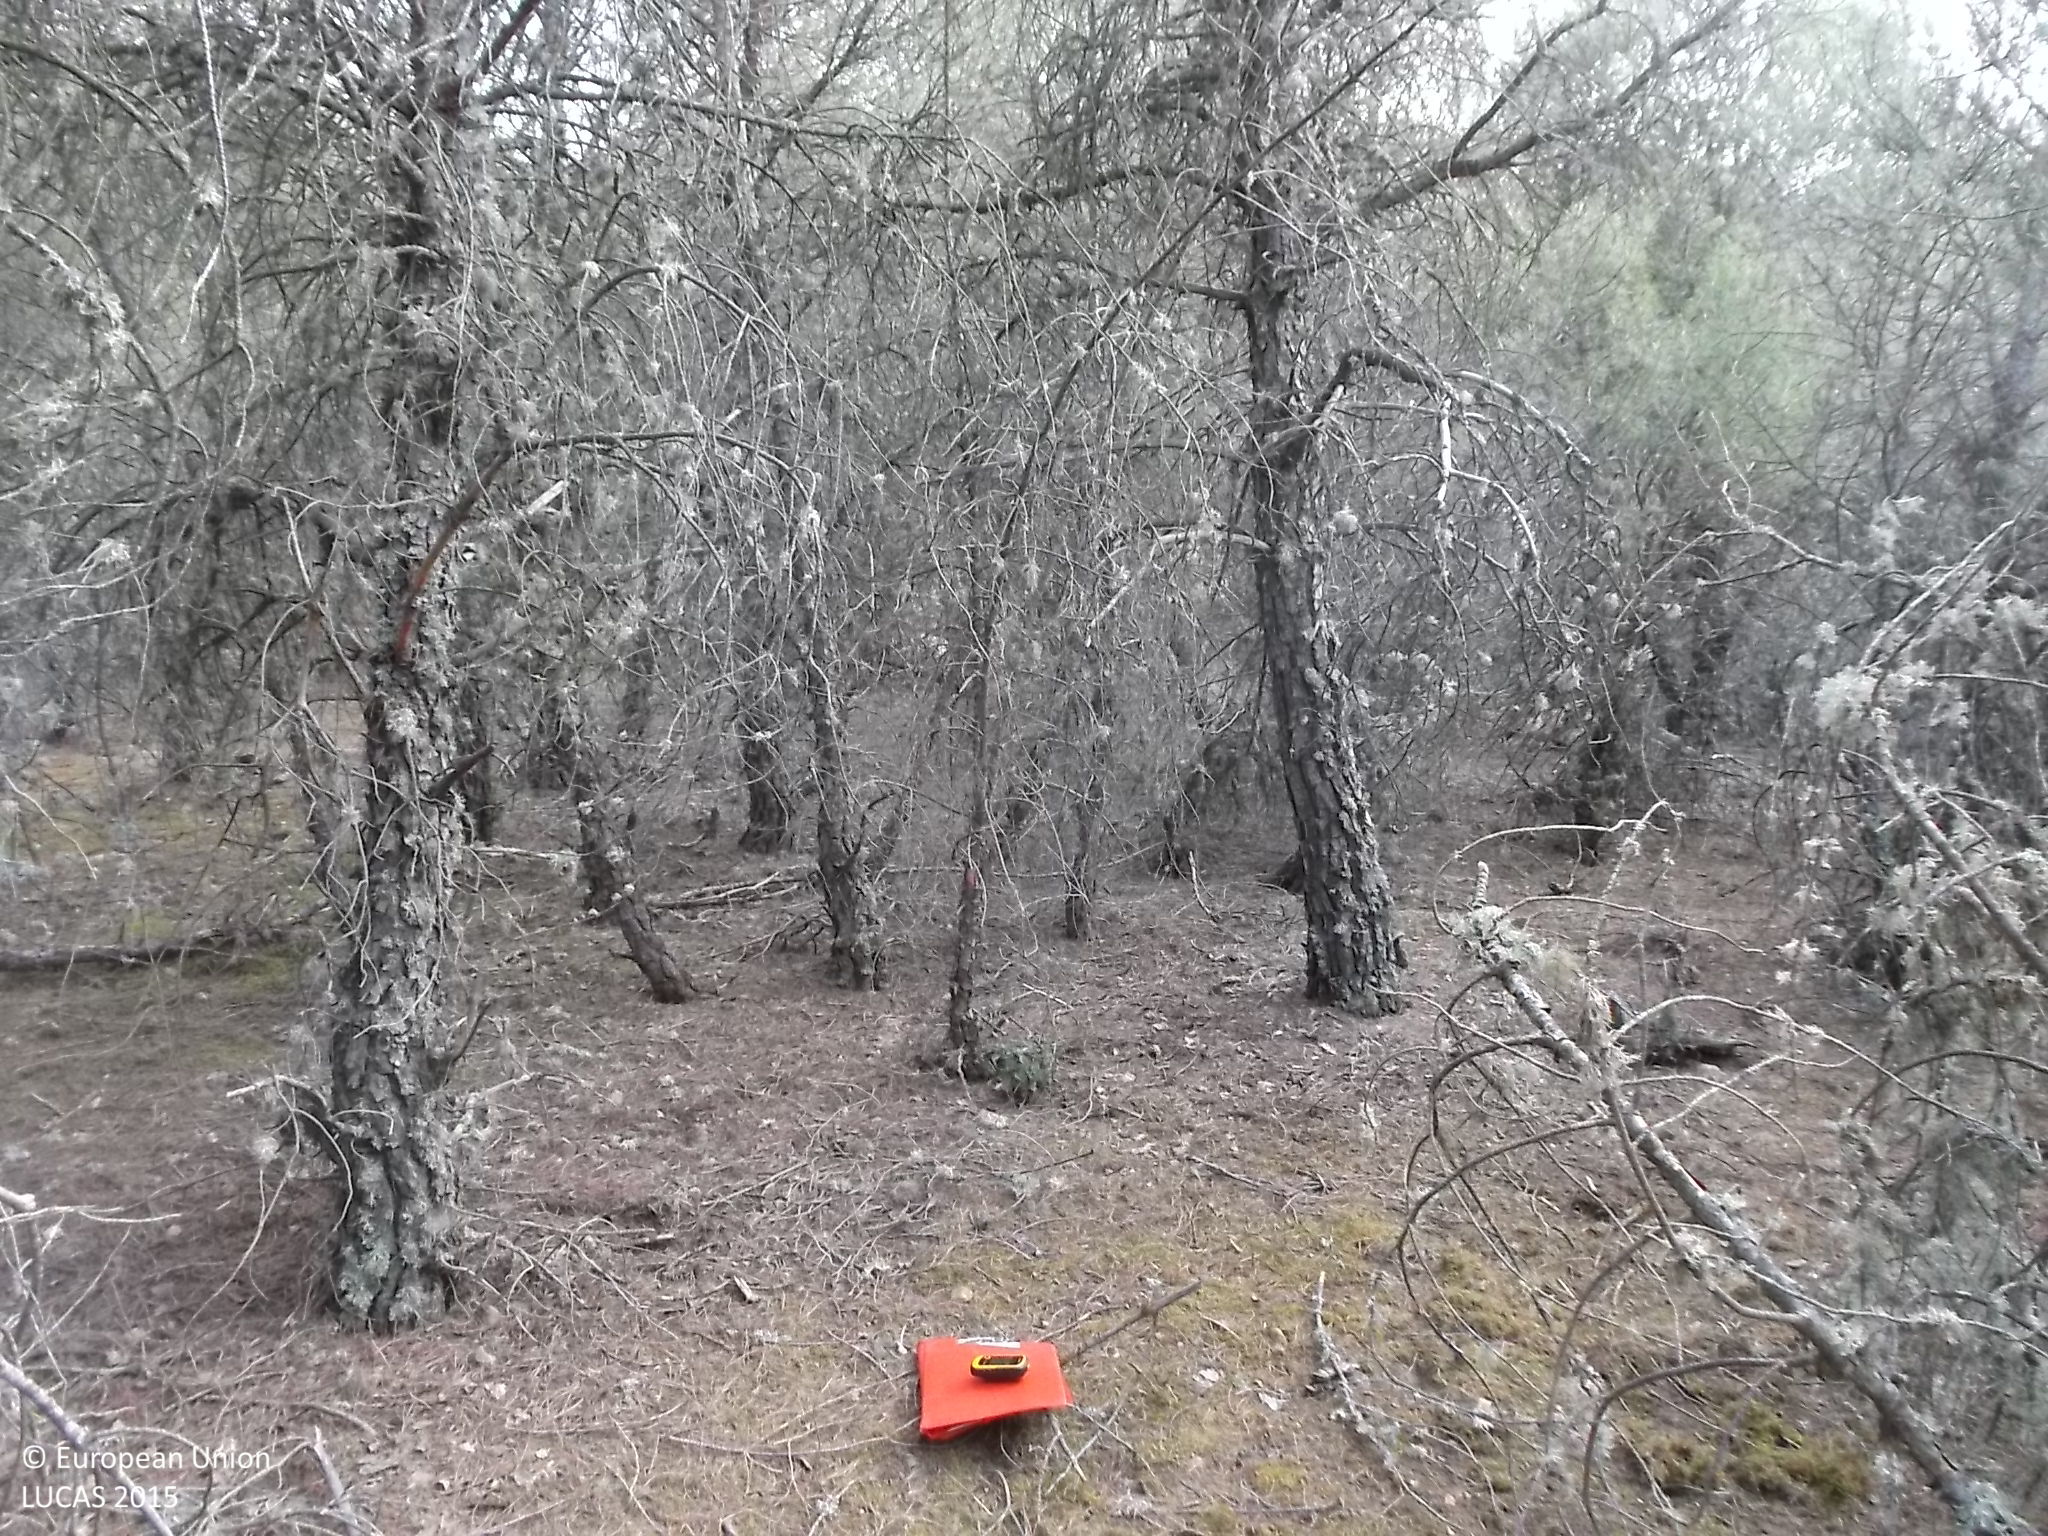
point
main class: Woodland
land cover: Pine dominated coniferous woodland
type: coniferous forest of the mediterranean region
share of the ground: > 75 %
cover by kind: coniferous forest trees 80 %, shrubs 20 %
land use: Semi-natural and natural areas not in use
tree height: > 5 m
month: July
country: ES
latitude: 41.5361
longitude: -5.4349
